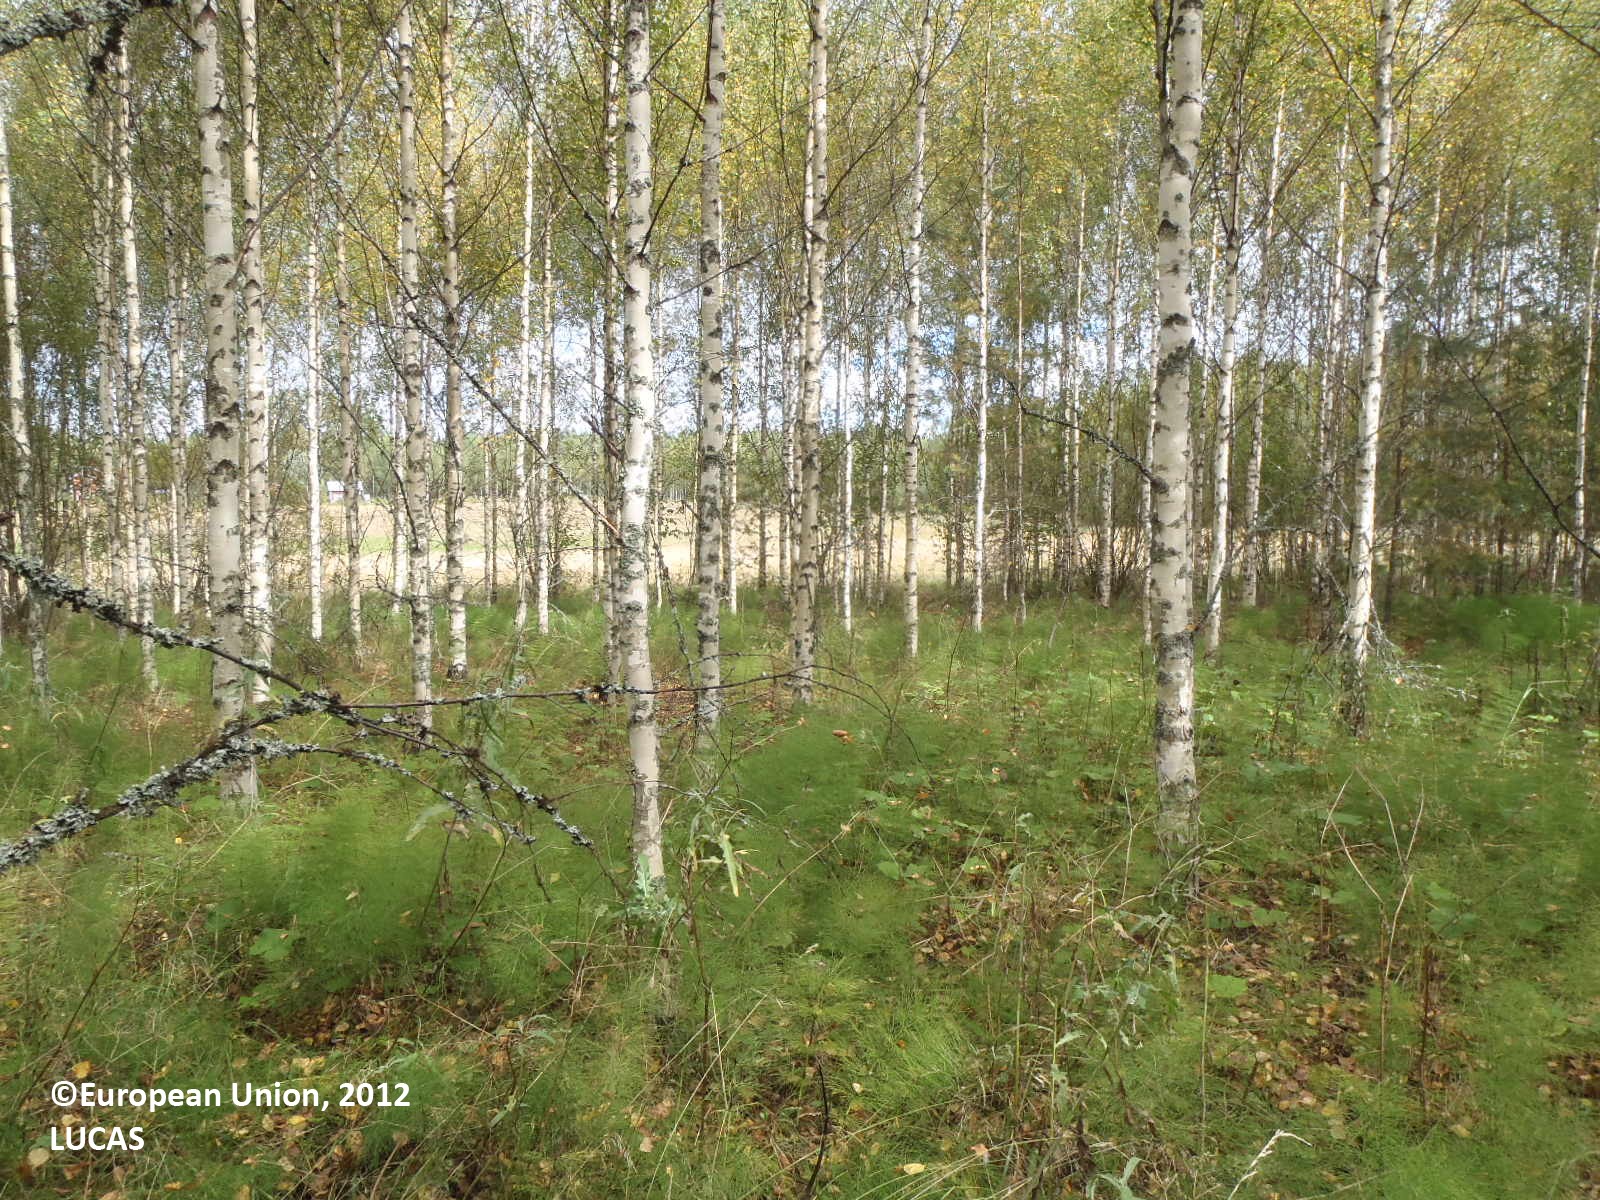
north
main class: Woodland
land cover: Broadleaved woodland
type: boreal forest
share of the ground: > 75 %
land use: Forestry
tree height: > 5 m
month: September
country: FI
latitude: 61.3206
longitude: 22.7138
